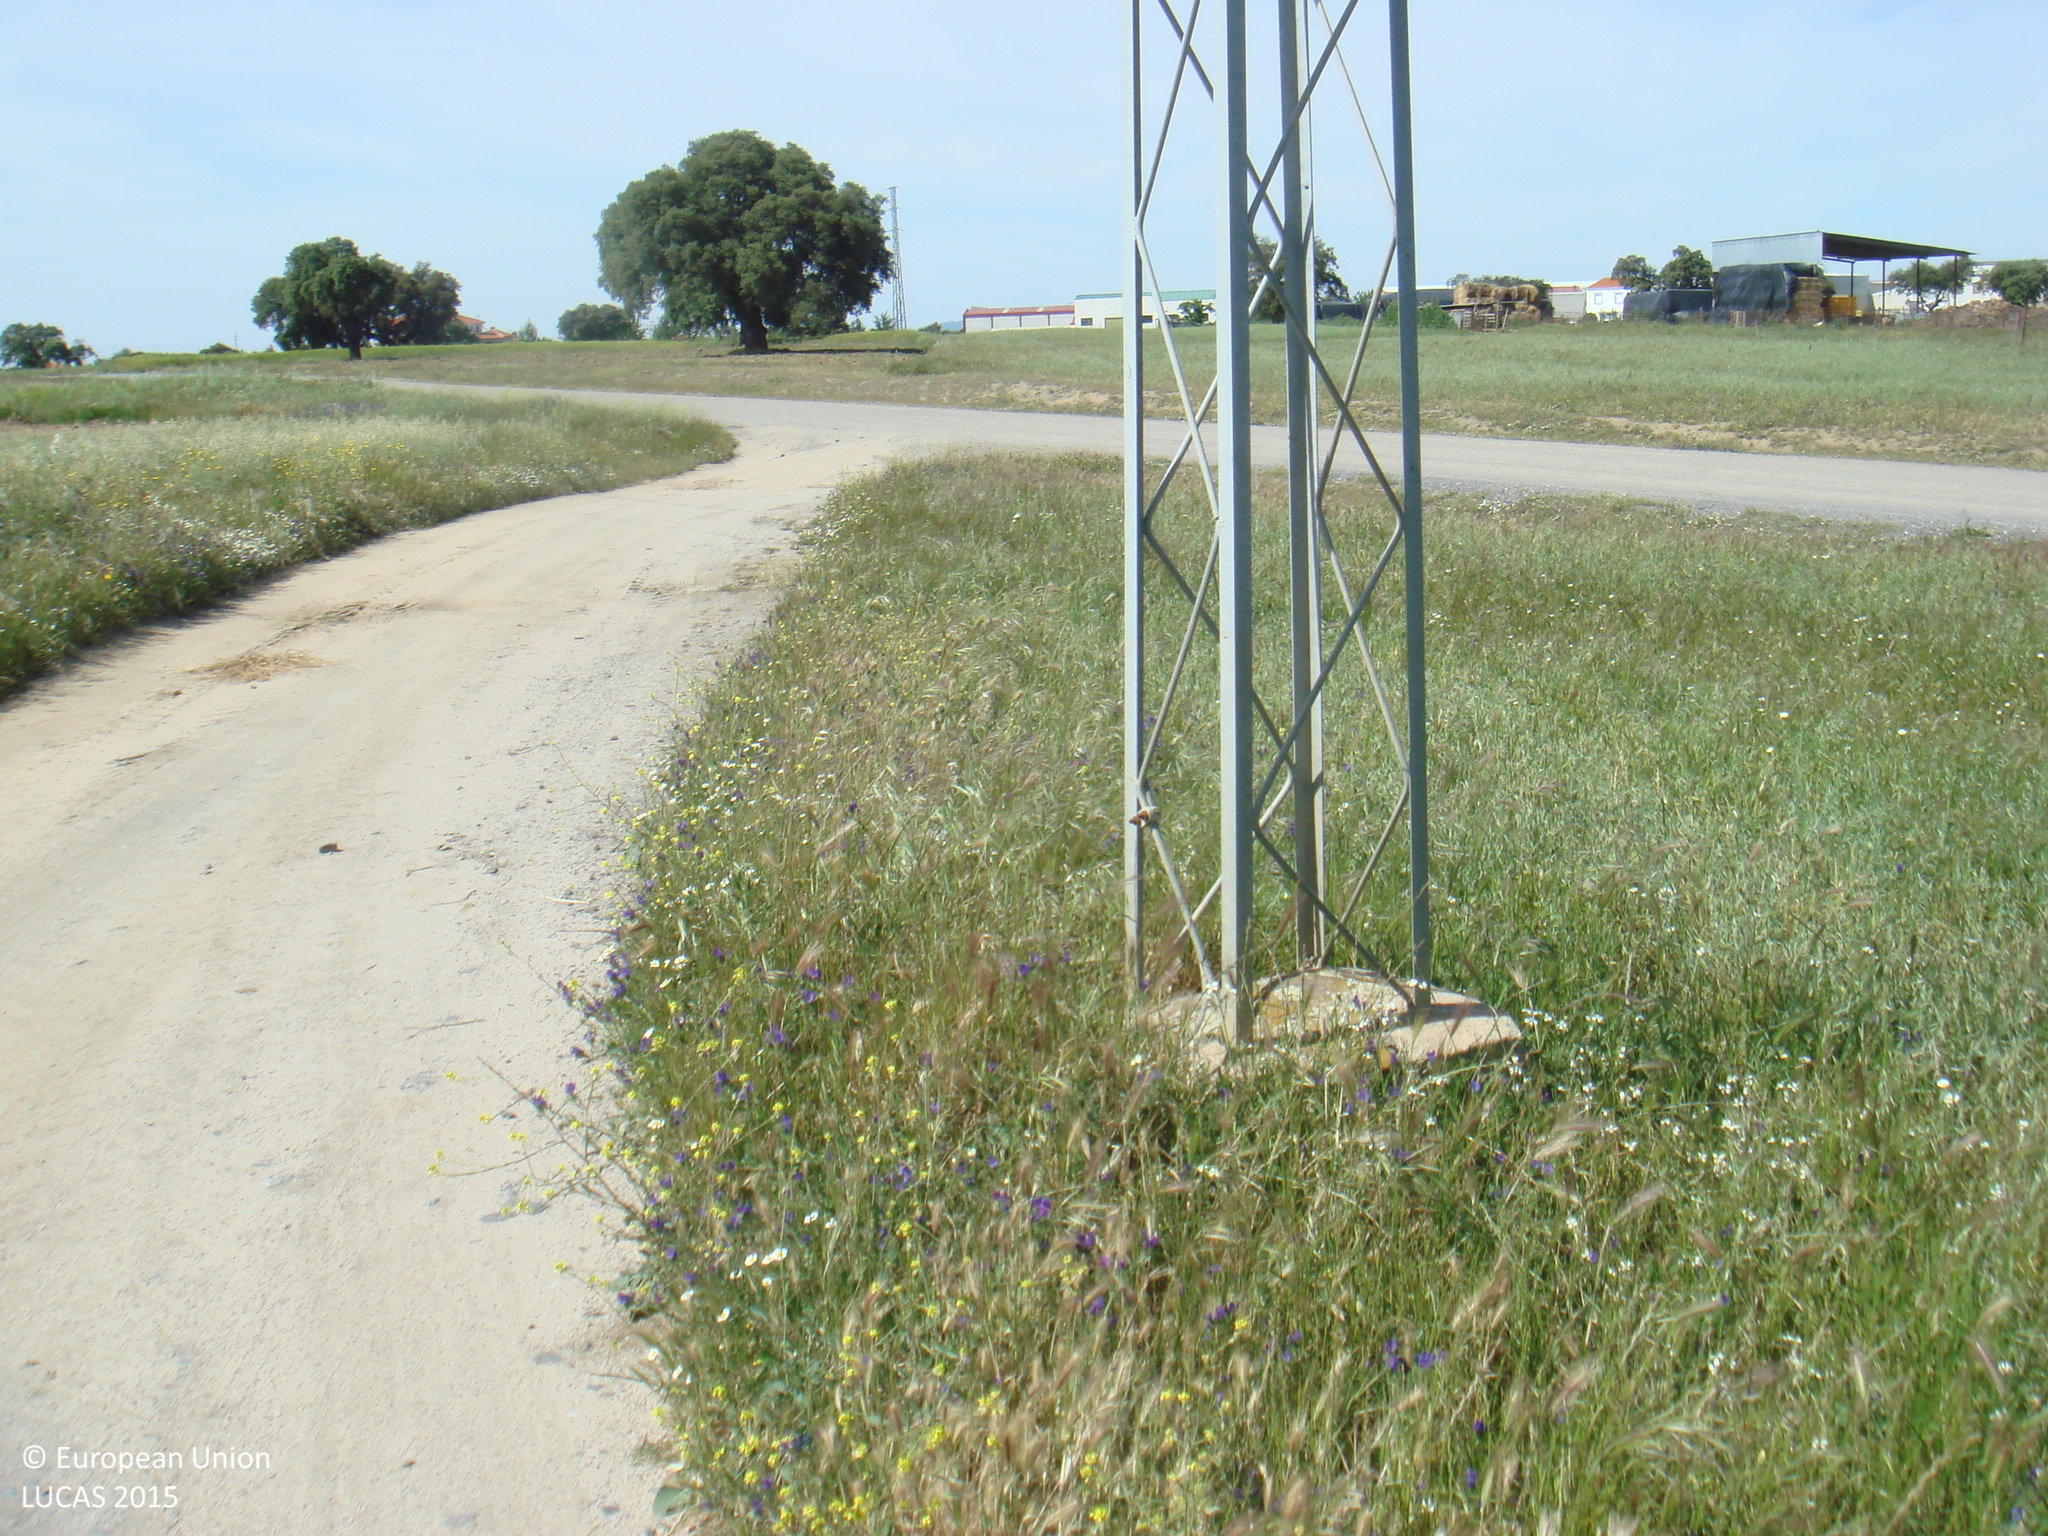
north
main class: Cropland
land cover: Mixed cereals for fodder
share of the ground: 25 - 50 %
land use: Agriculture (excluding fallow land and kitchen gardens)
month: April
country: ES
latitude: 38.4804
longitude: -5.1263
